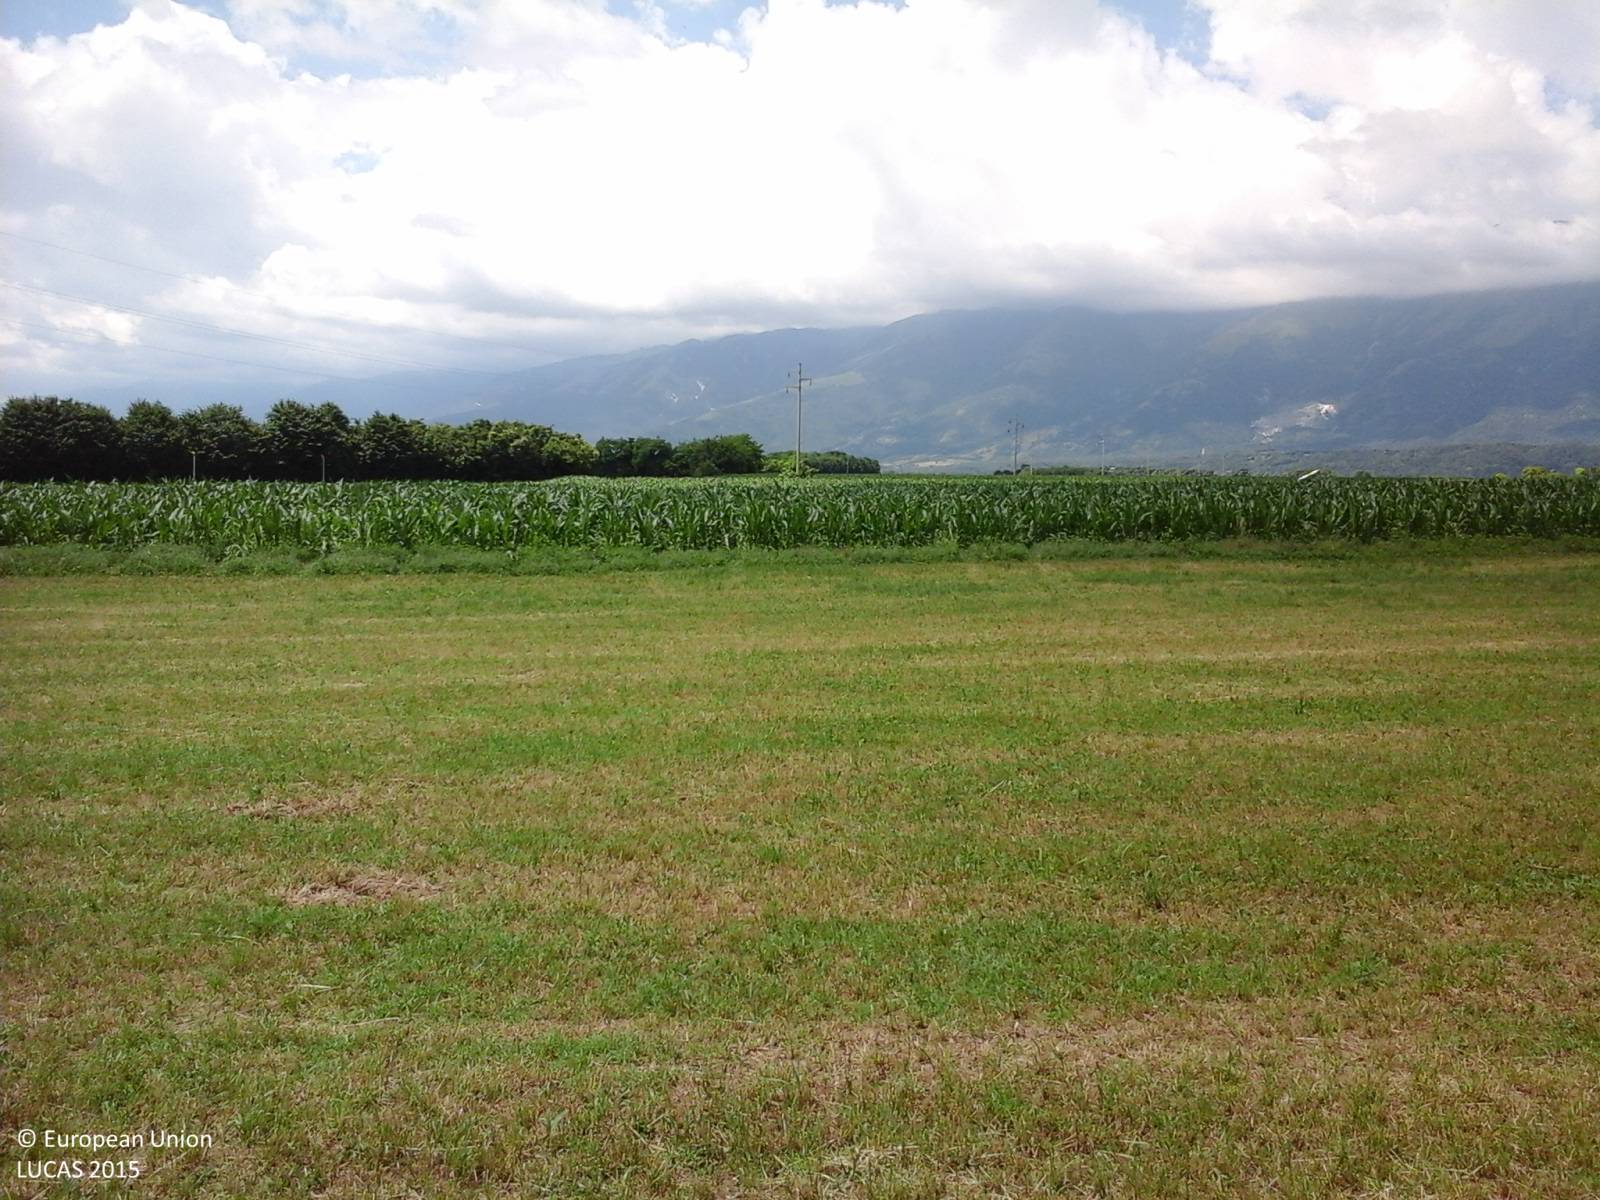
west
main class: Grassland
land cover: Grassland without tree/shrub cover
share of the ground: > 75 %
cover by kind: herbaceous plants 100 %
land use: Agriculture (excluding fallow land and kitchen gardens)
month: June
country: IT
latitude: 46.1015
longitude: 12.6745
